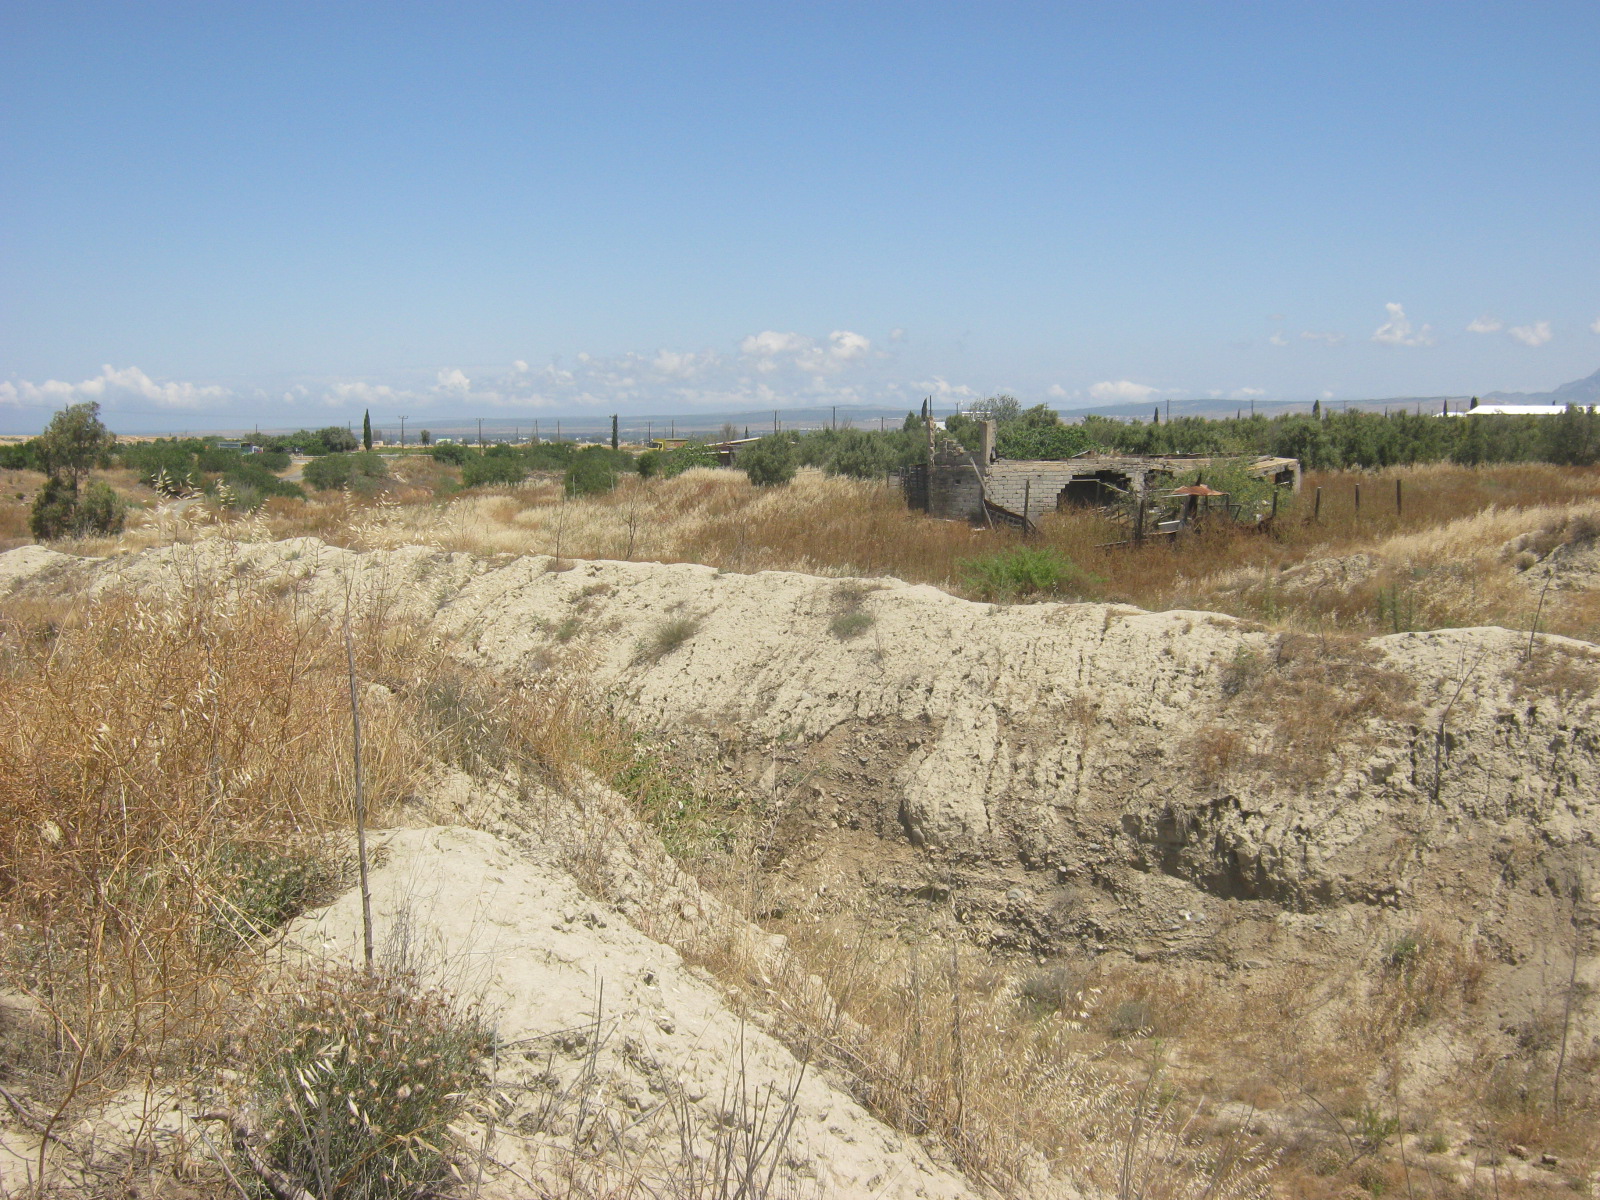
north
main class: Shrubland
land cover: Shrubland without tree cover
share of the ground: 50 - 75 %
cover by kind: herbaceous plants 55 %, unconsolidated bare surface 30 %, shrubs 15 %
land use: Semi-natural and natural areas not in use
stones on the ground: < 10 %
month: May
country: CY
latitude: 35.1276
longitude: 33.0152
